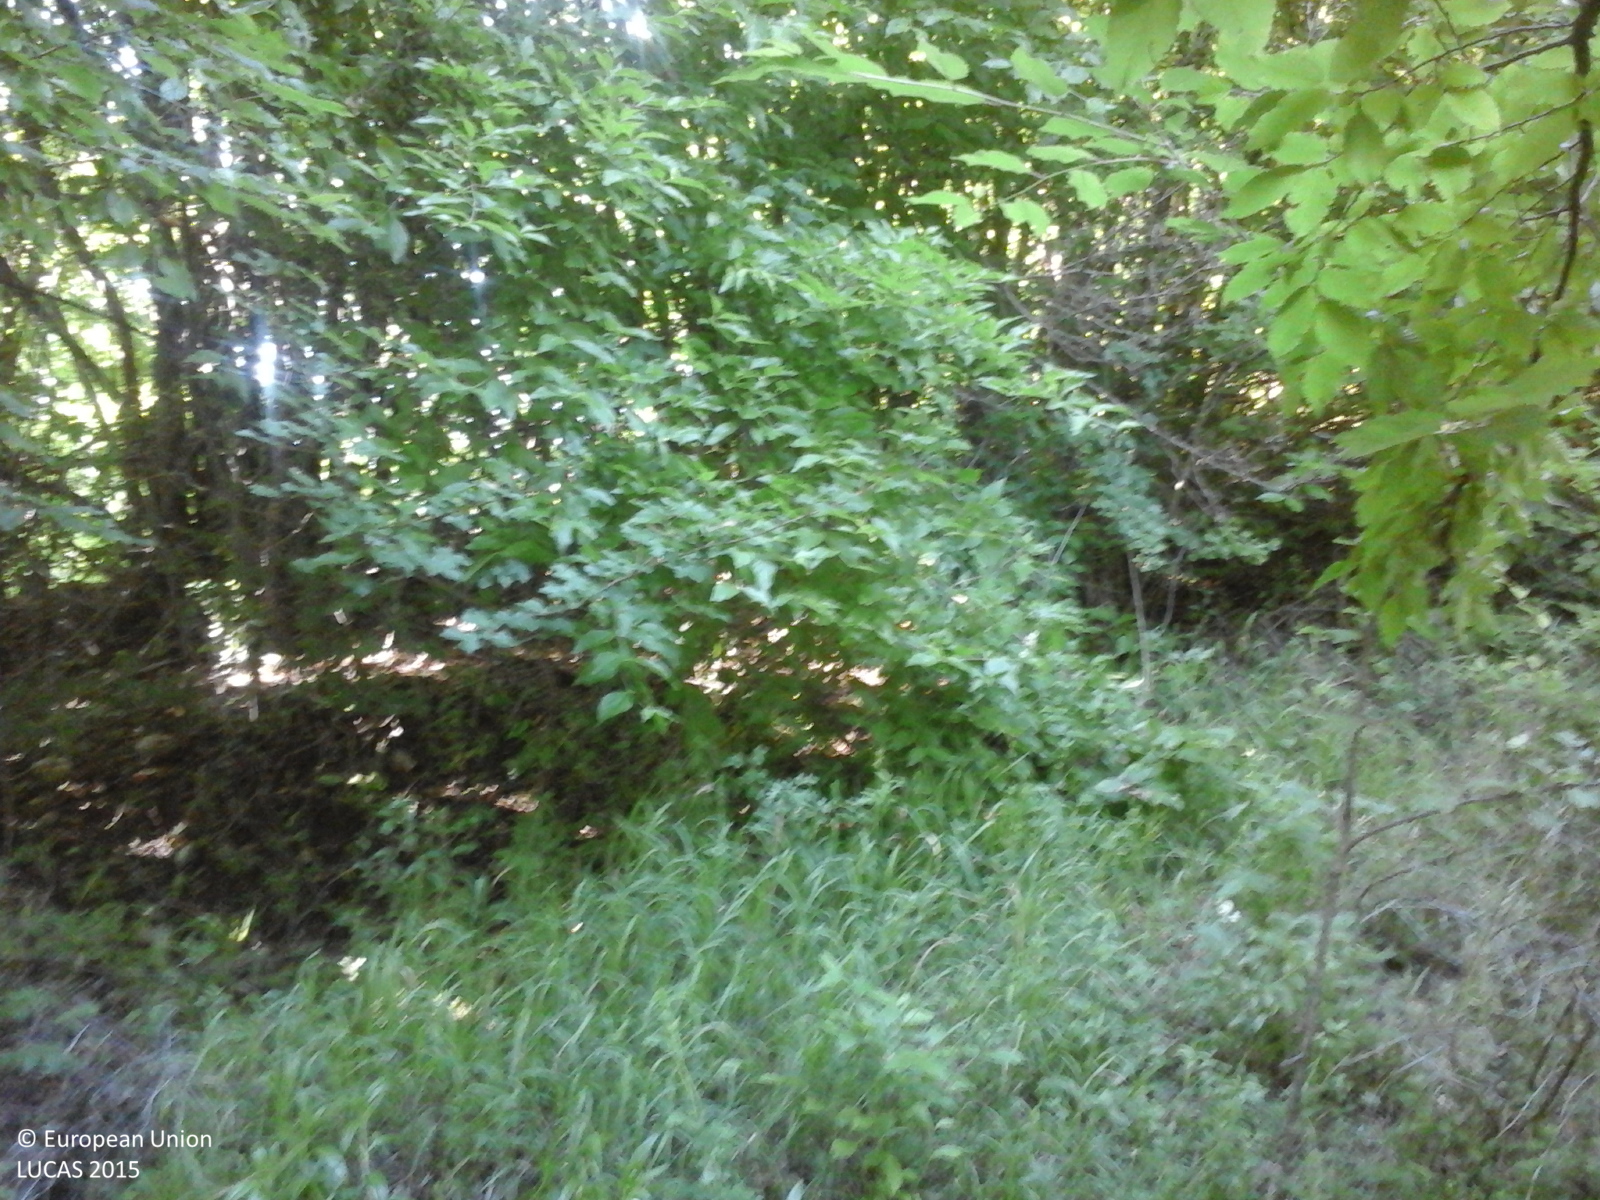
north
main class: Woodland
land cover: Broadleaved woodland
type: beech forest
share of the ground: > 75 %
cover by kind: broadleaved forest trees 100 %
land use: Forestry
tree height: > 5 m
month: June
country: RO
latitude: 45.1135
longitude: 25.6724
